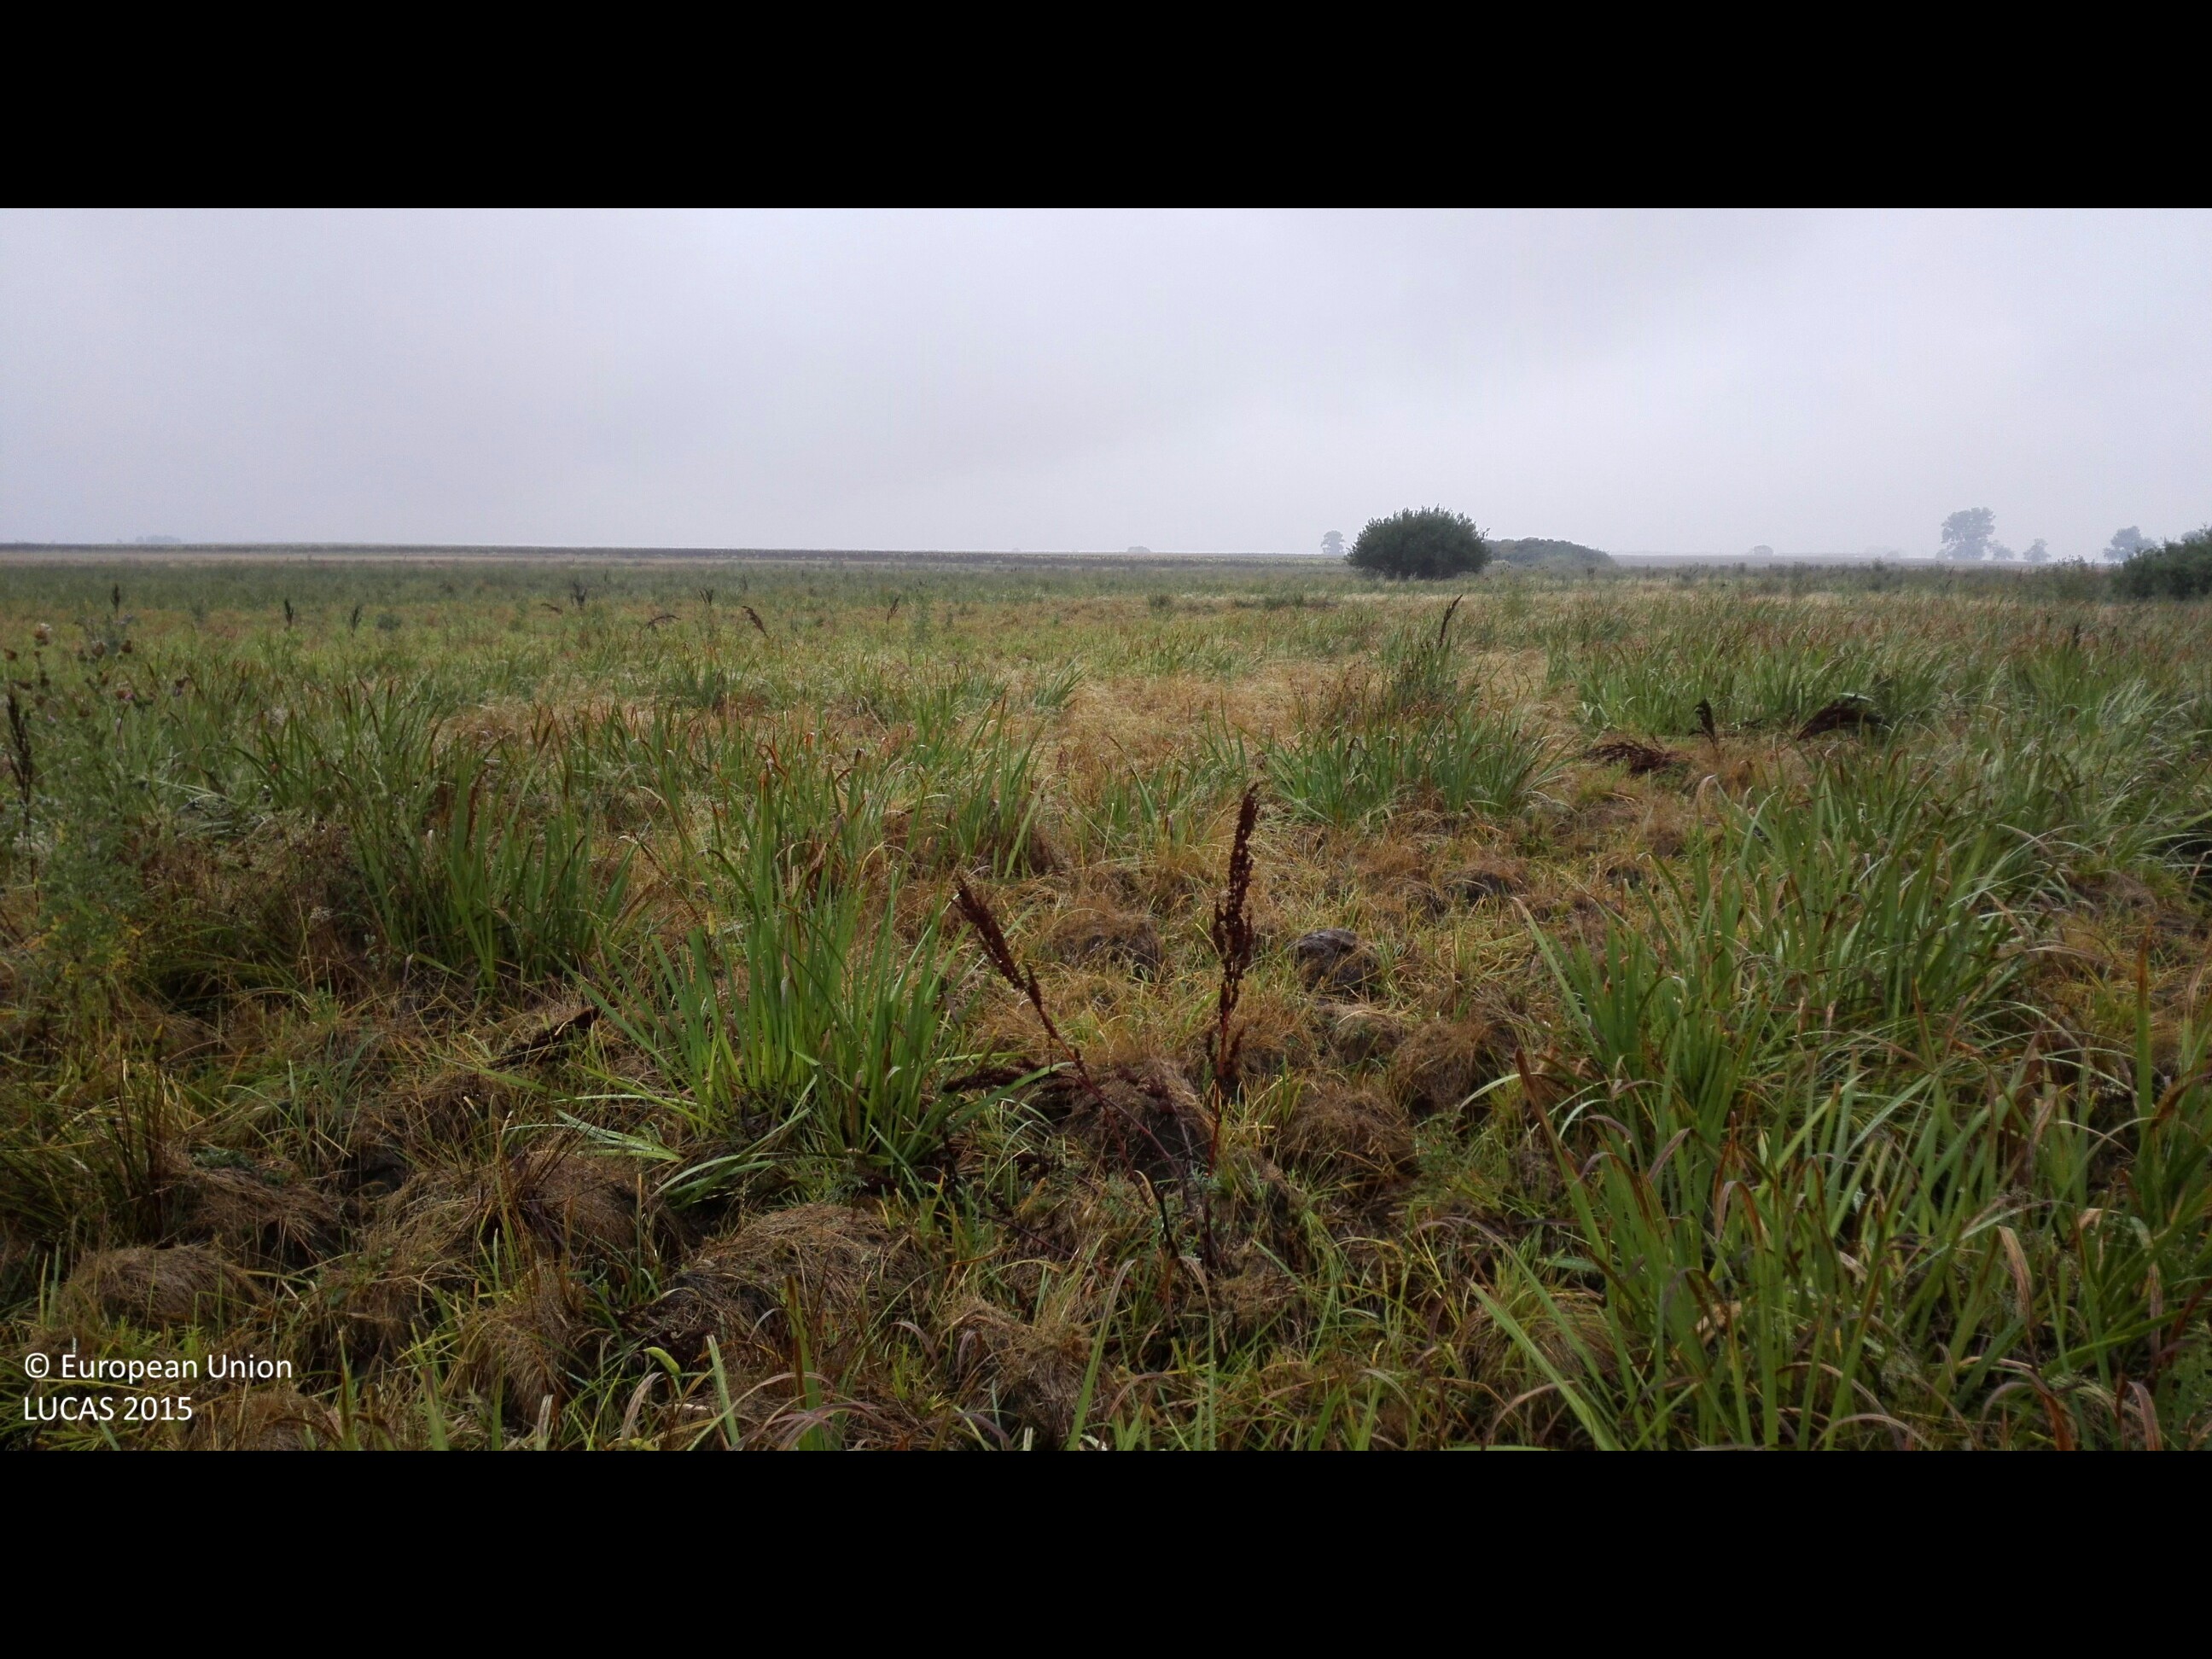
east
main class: Grassland
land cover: Spontaneously vegetated surfaces
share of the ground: > 75 %
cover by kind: herbaceous plants 100 %
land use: Agriculture (excluding fallow land and kitchen gardens)
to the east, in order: Spontaneously vegetated surfaces; Grassland without tree/shrub cover
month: August
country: HU
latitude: 47.2094
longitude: 21.5950
